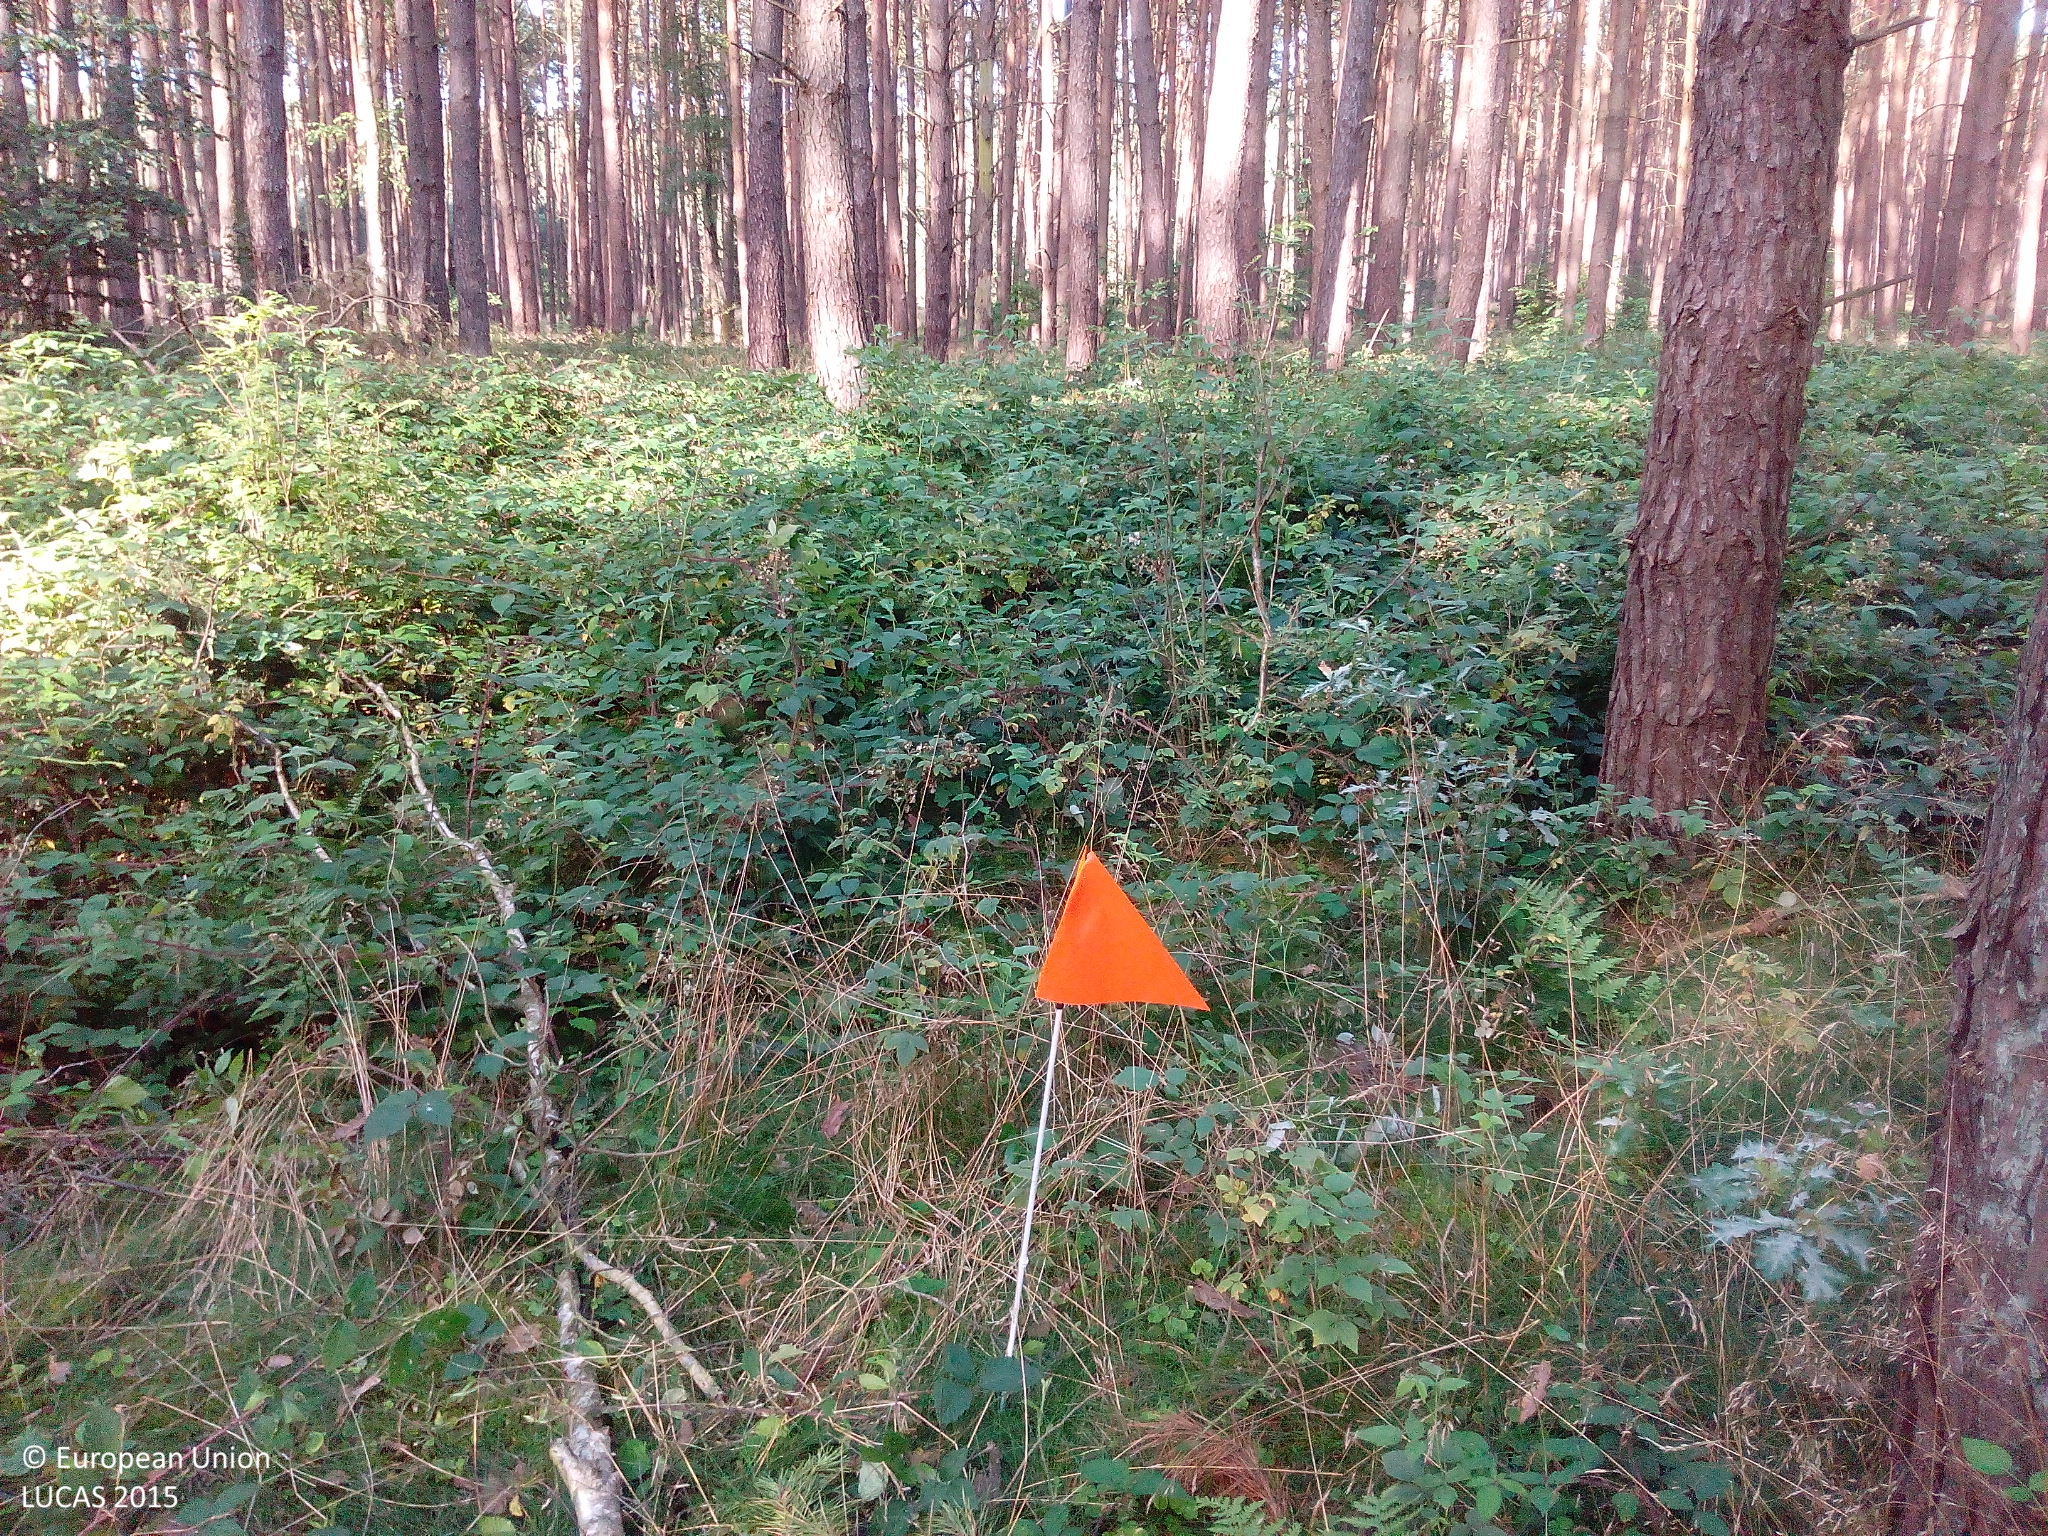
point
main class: Woodland
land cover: Pine dominated coniferous woodland
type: hemiboreal forest and nemoral coniferous forest and mixed broadleaved-coniferous forest
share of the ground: > 75 %
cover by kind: coniferous forest trees 80 %, shrubs 10 %, herbaceous plants 10 %
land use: Forestry
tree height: > 5 m
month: August
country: DE
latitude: 53.5388
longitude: 12.4588
